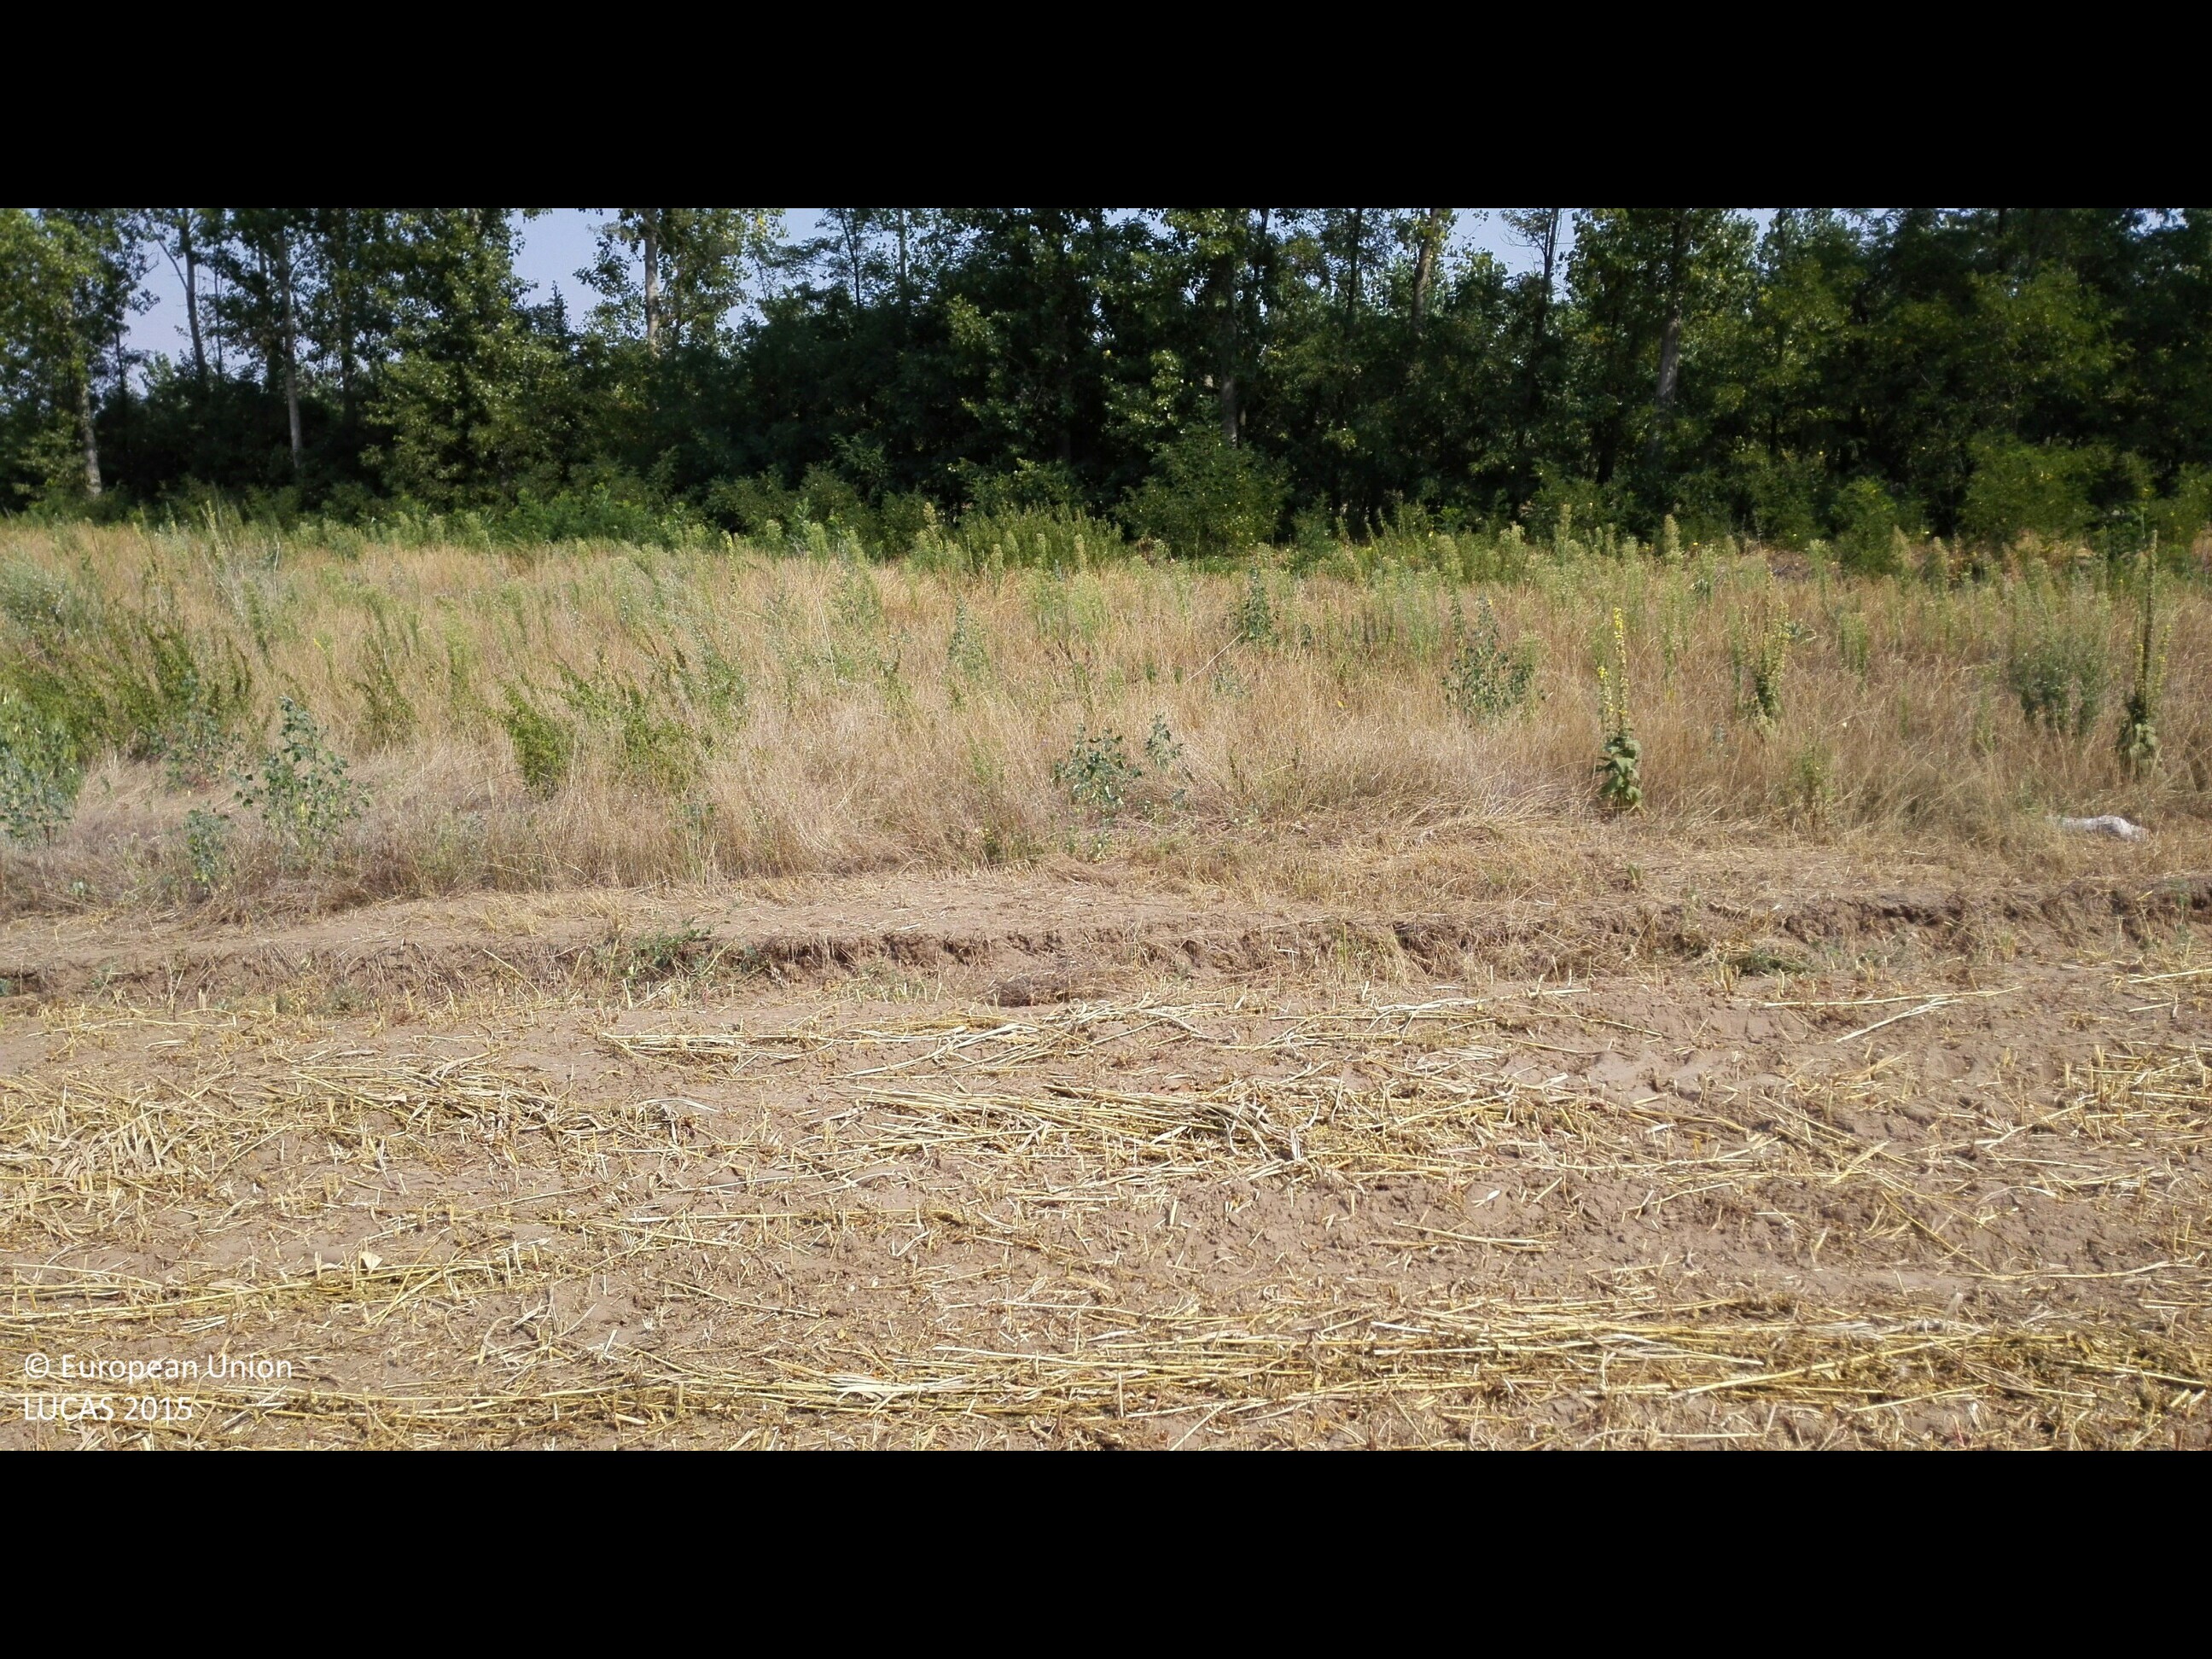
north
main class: Cropland
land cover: Rape and turnip rape
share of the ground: 10 - 25 %
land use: Agriculture (excluding fallow land and kitchen gardens)
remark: Harvested field
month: August
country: HU
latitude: 47.4757
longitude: 21.6552
